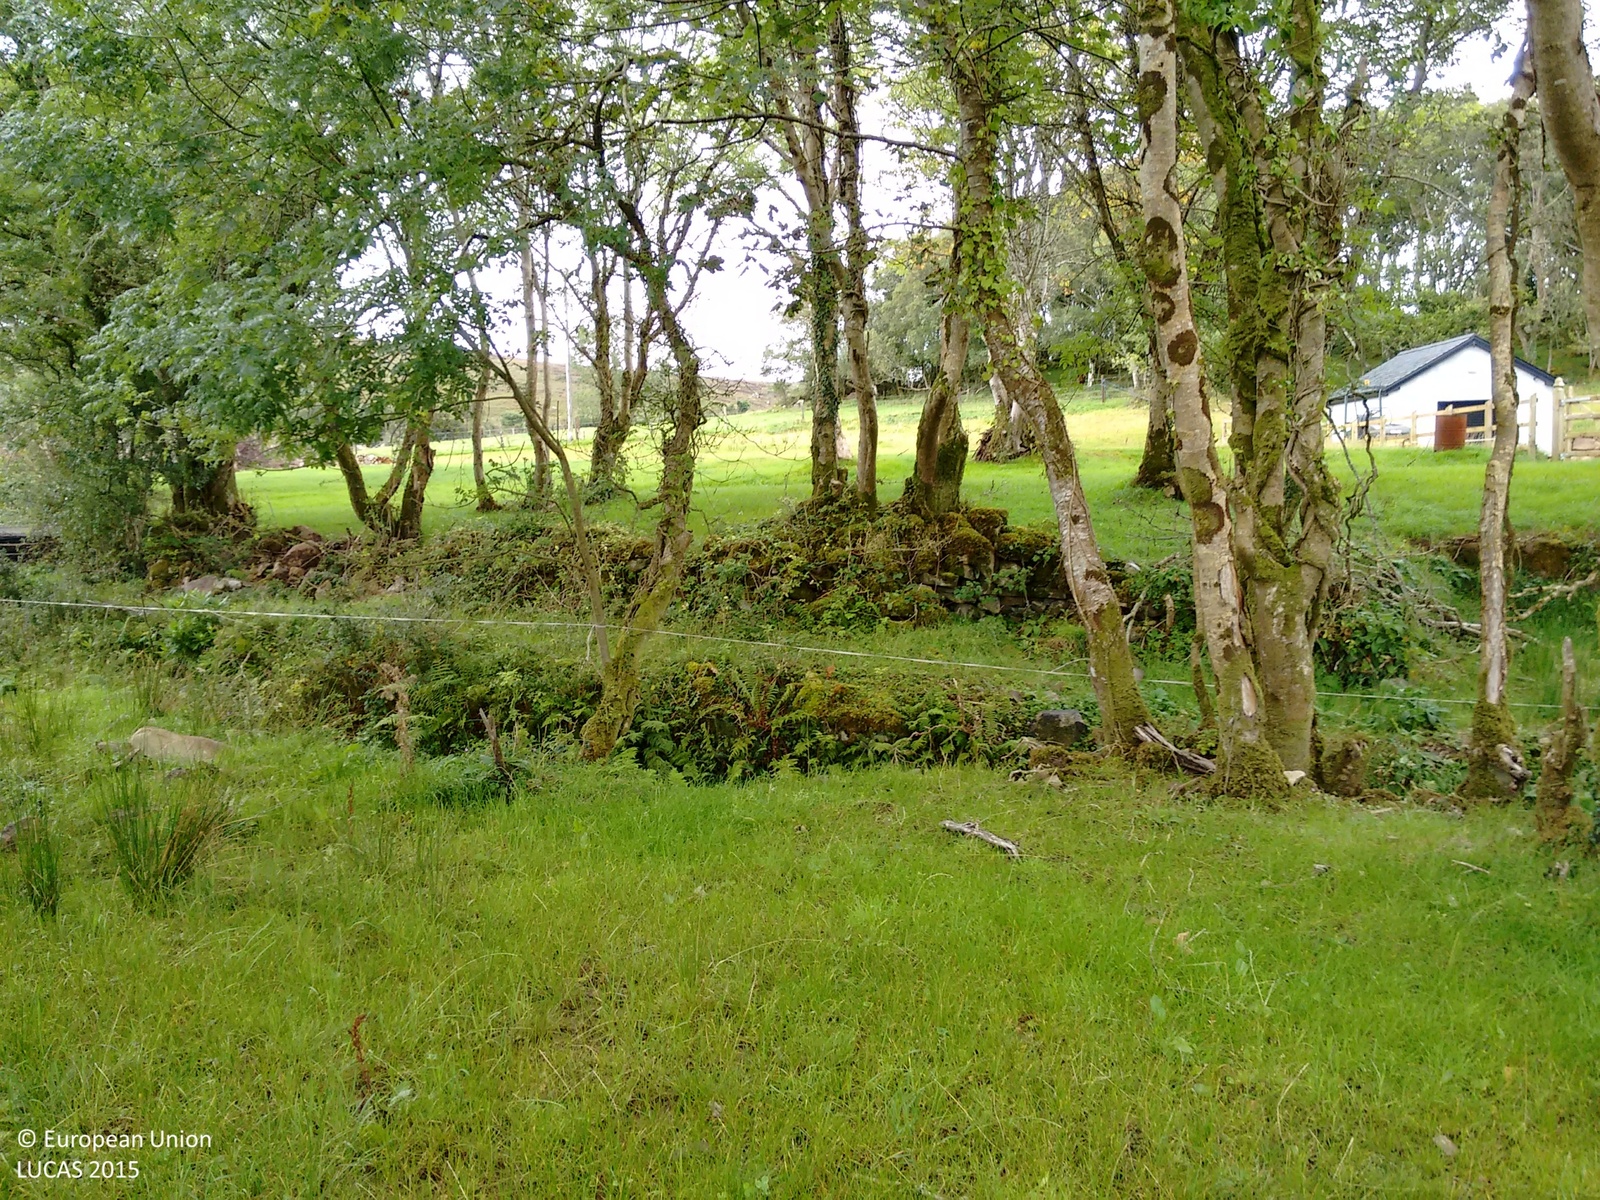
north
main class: Woodland
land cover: Broadleaved woodland
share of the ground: > 75 %
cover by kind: broadleaved forest trees 75 %, herbaceous plants 25 %
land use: Agriculture (excluding fallow land and kitchen gardens)
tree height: < 5 m
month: September
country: IE
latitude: 54.0159
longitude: -9.2844
